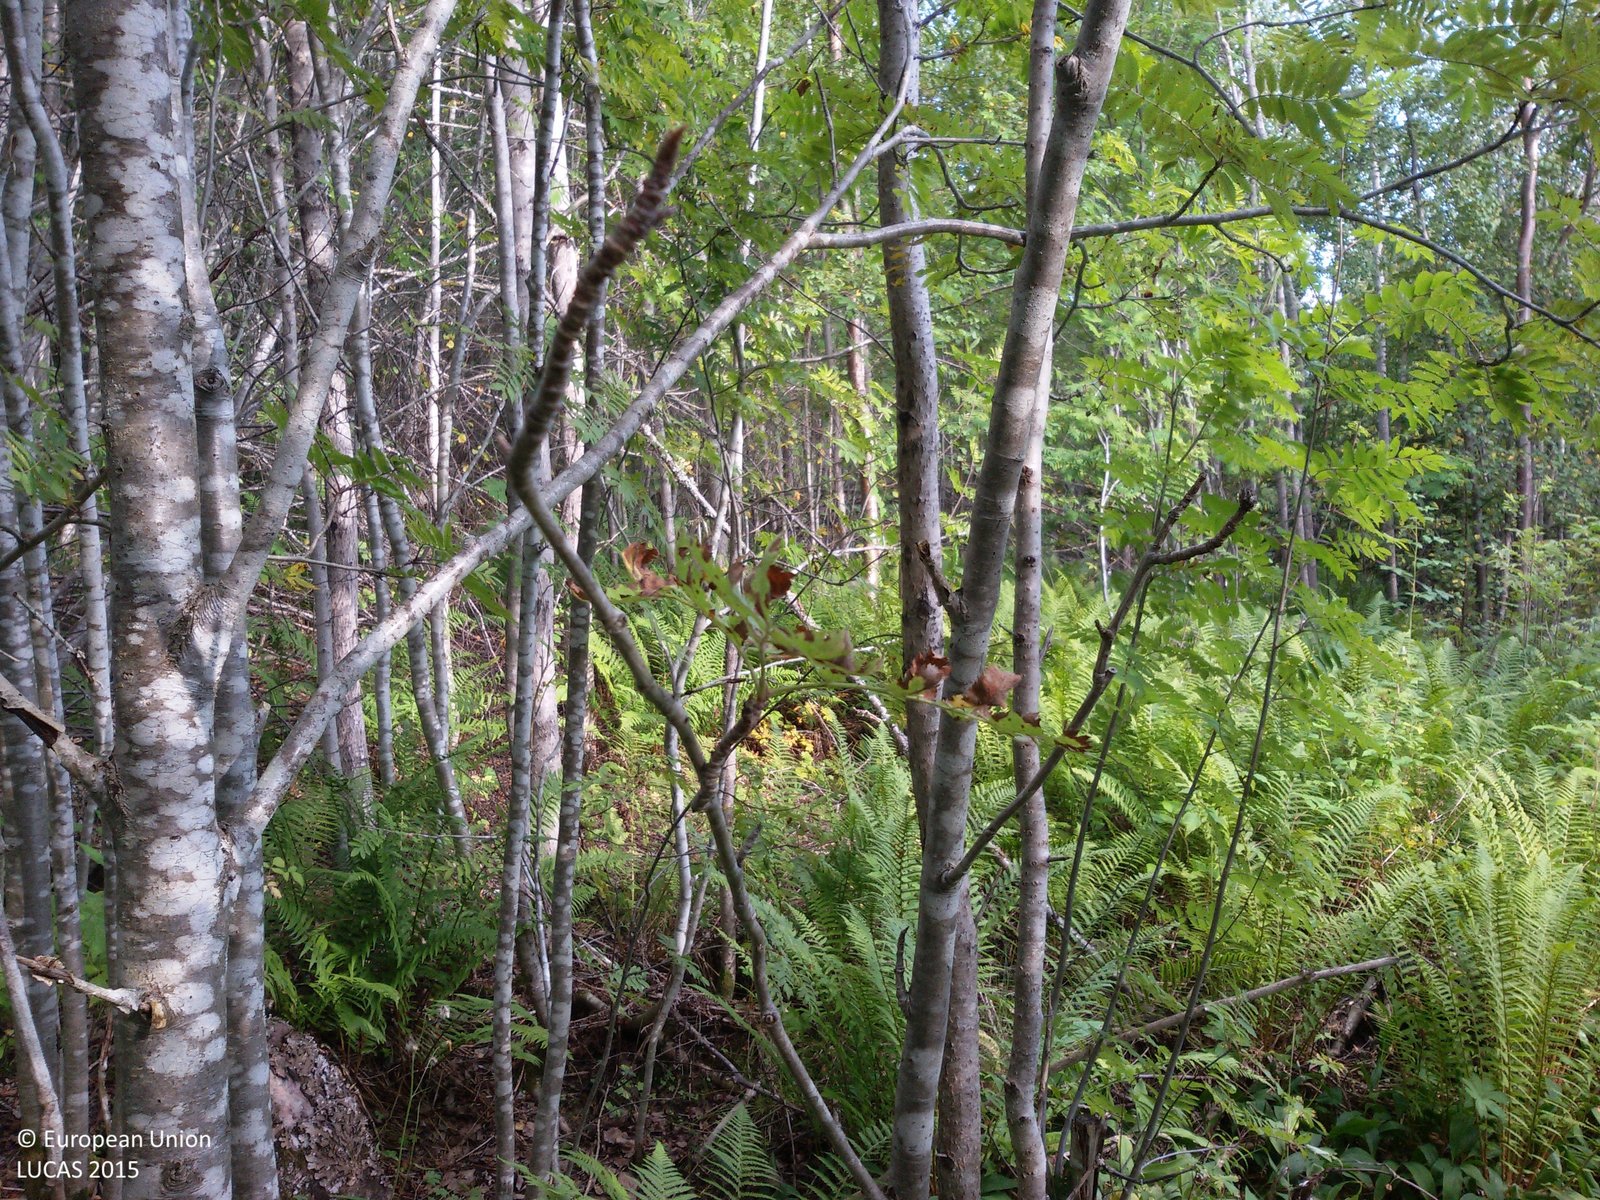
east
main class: Woodland
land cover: Broadleaved woodland
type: hemiboreal forest and nemoral coniferous forest and mixed broadleaved-coniferous forest
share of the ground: 50 - 75 %
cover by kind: broadleaved forest trees 90 %, herbaceous plants 10 %
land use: Forestry
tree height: > 5 m
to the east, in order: Broadleaved woodland; Ditches and canals; Paved roads, cycling and walking lanes; Grassland without tree/shrub cover; Broadleaved woodland; Electric lines; Broadleaved woodland
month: August
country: SE
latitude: 60.8282
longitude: 16.0375
